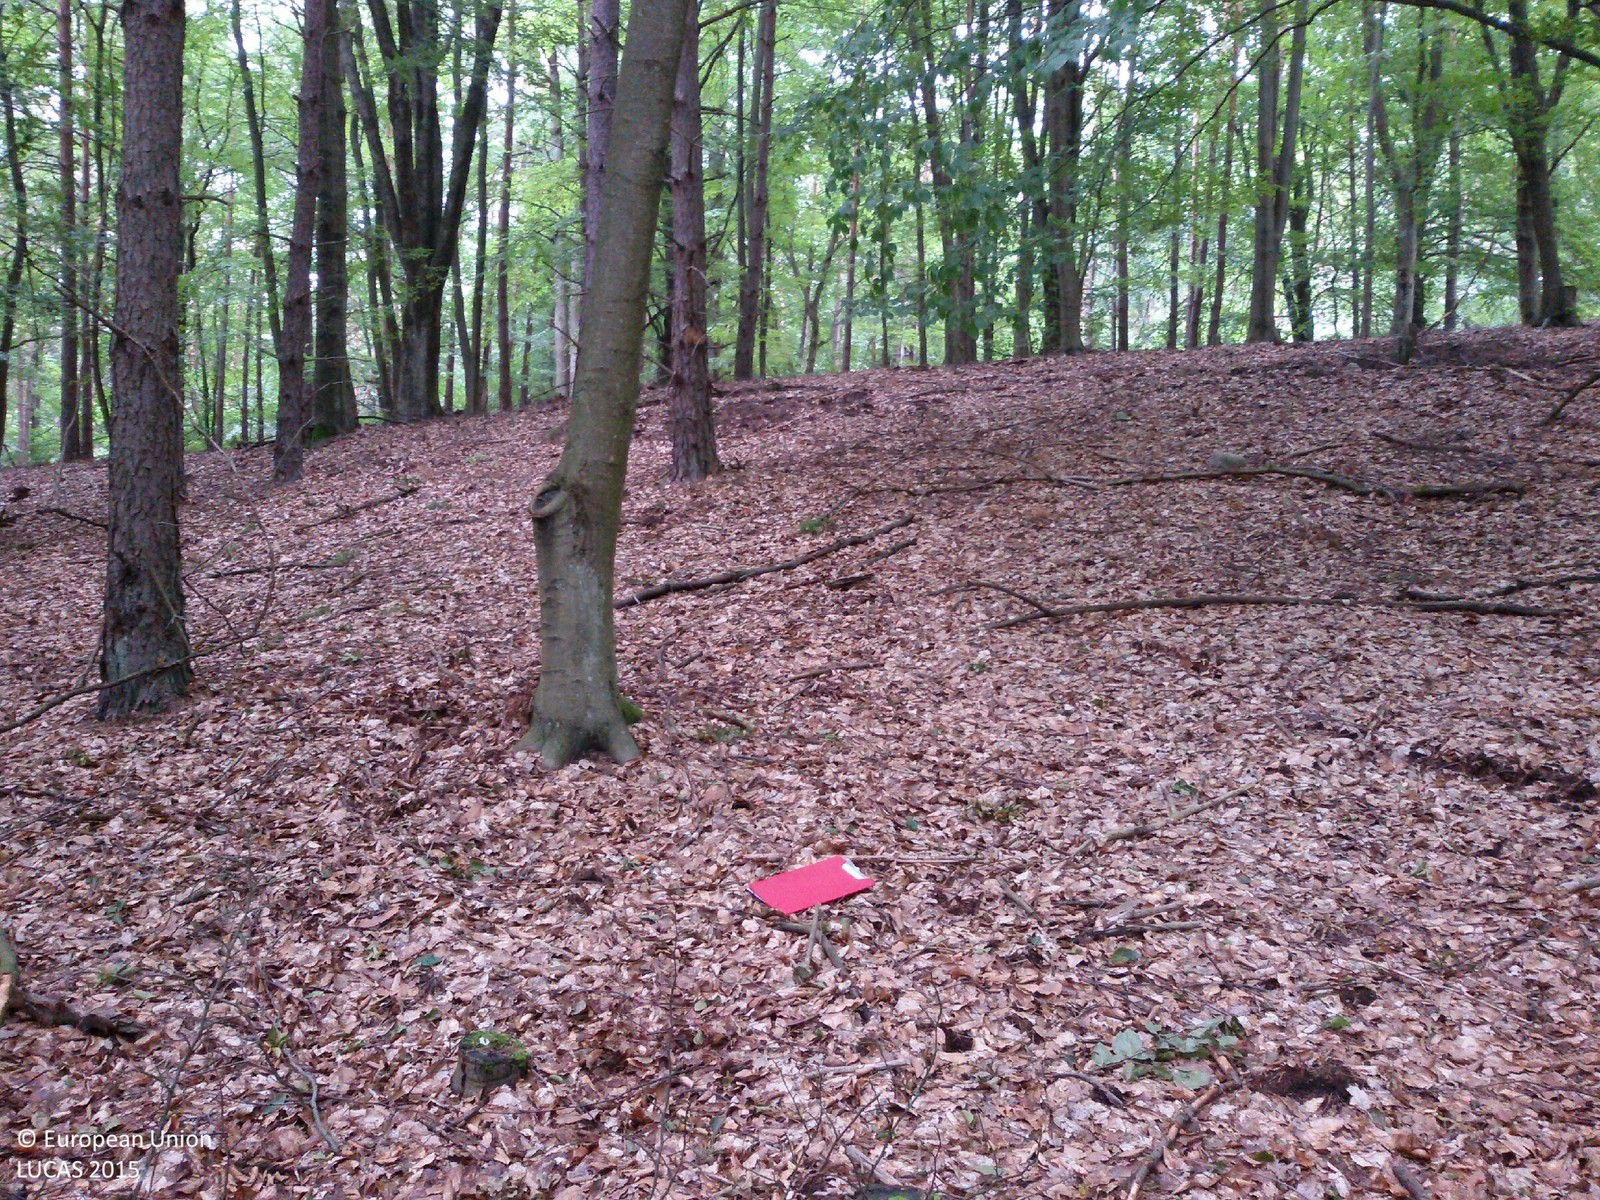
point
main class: Woodland
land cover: Other mixed woodland
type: hemiboreal forest and nemoral coniferous forest and mixed broadleaved-coniferous forest
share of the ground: > 75 %
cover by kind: broadleaved forest trees 65 %, coniferous forest trees 25 %, herbaceous plants 5 %, unconsolidated bare surface 5 %
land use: Forestry
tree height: > 5 m
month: July
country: PL
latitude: 53.1851
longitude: 16.2764
